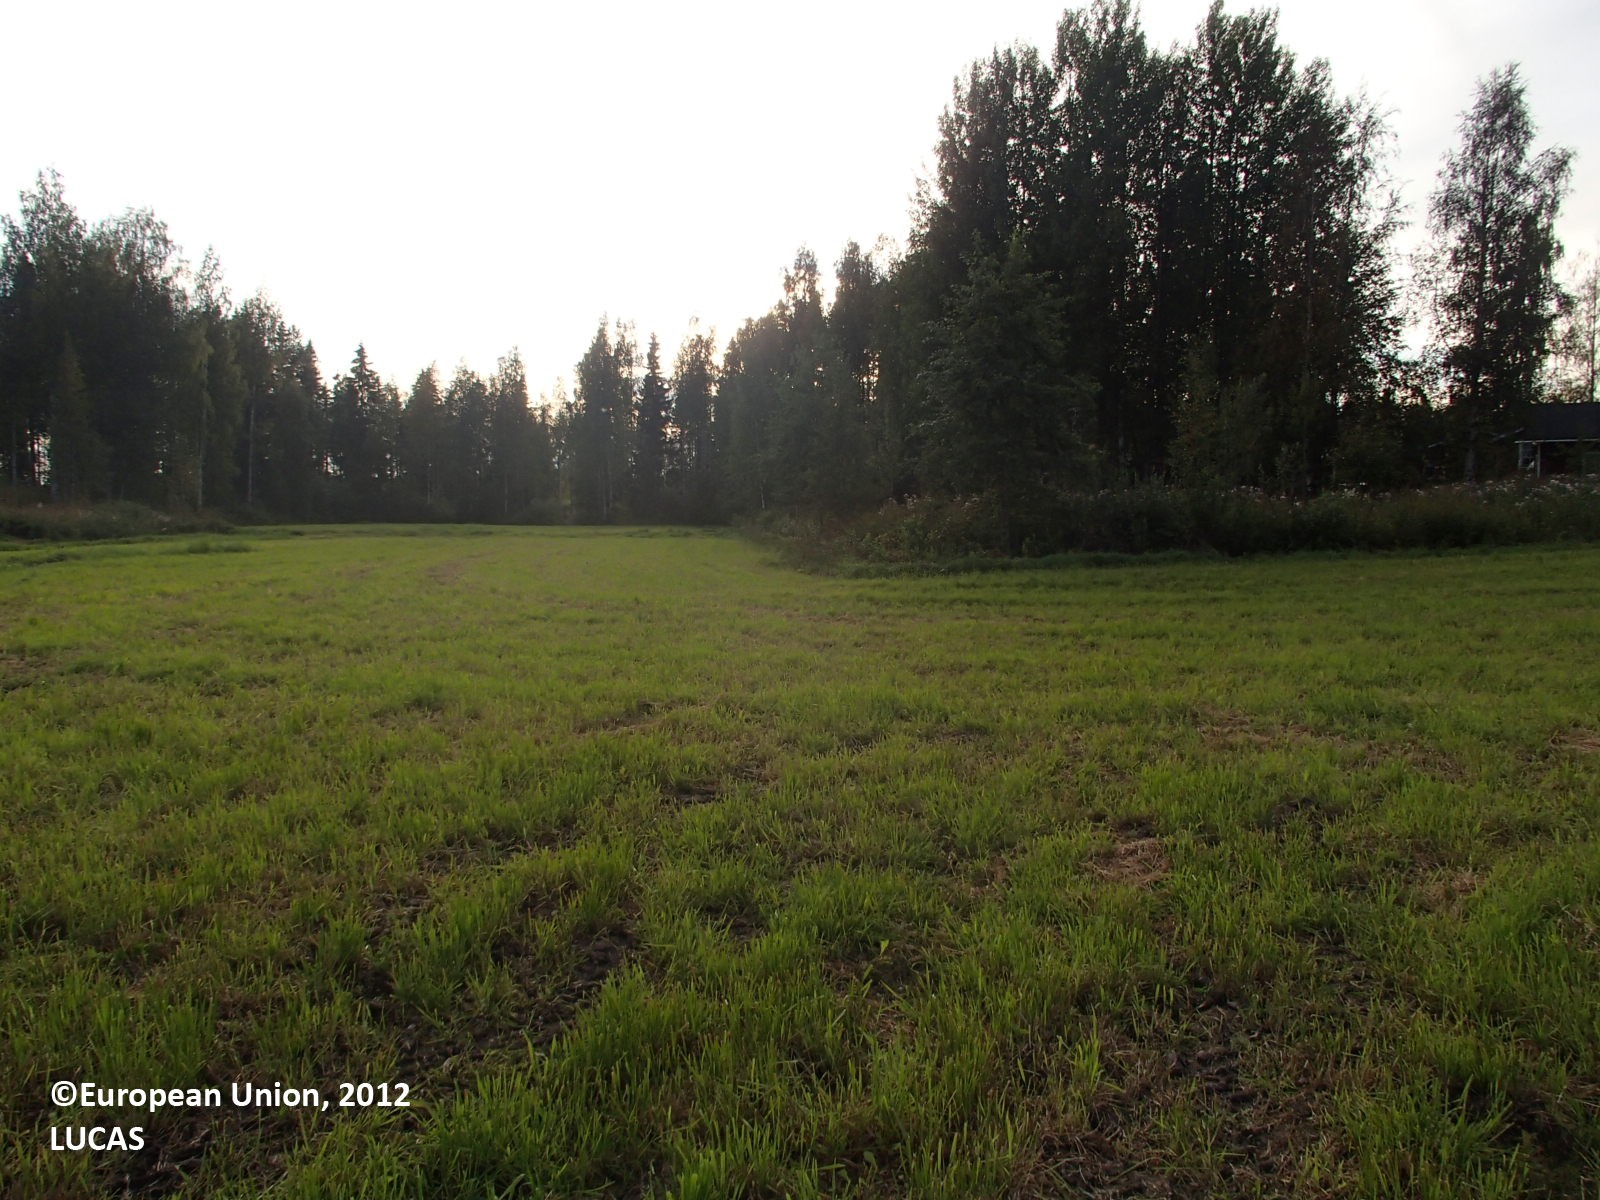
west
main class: Cropland
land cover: Temporary grasslands
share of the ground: > 75 %
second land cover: Barley
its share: < 10 %
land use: Agriculture (excluding fallow land and kitchen gardens)
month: August
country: FI
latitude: 63.3740
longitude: 27.9932
